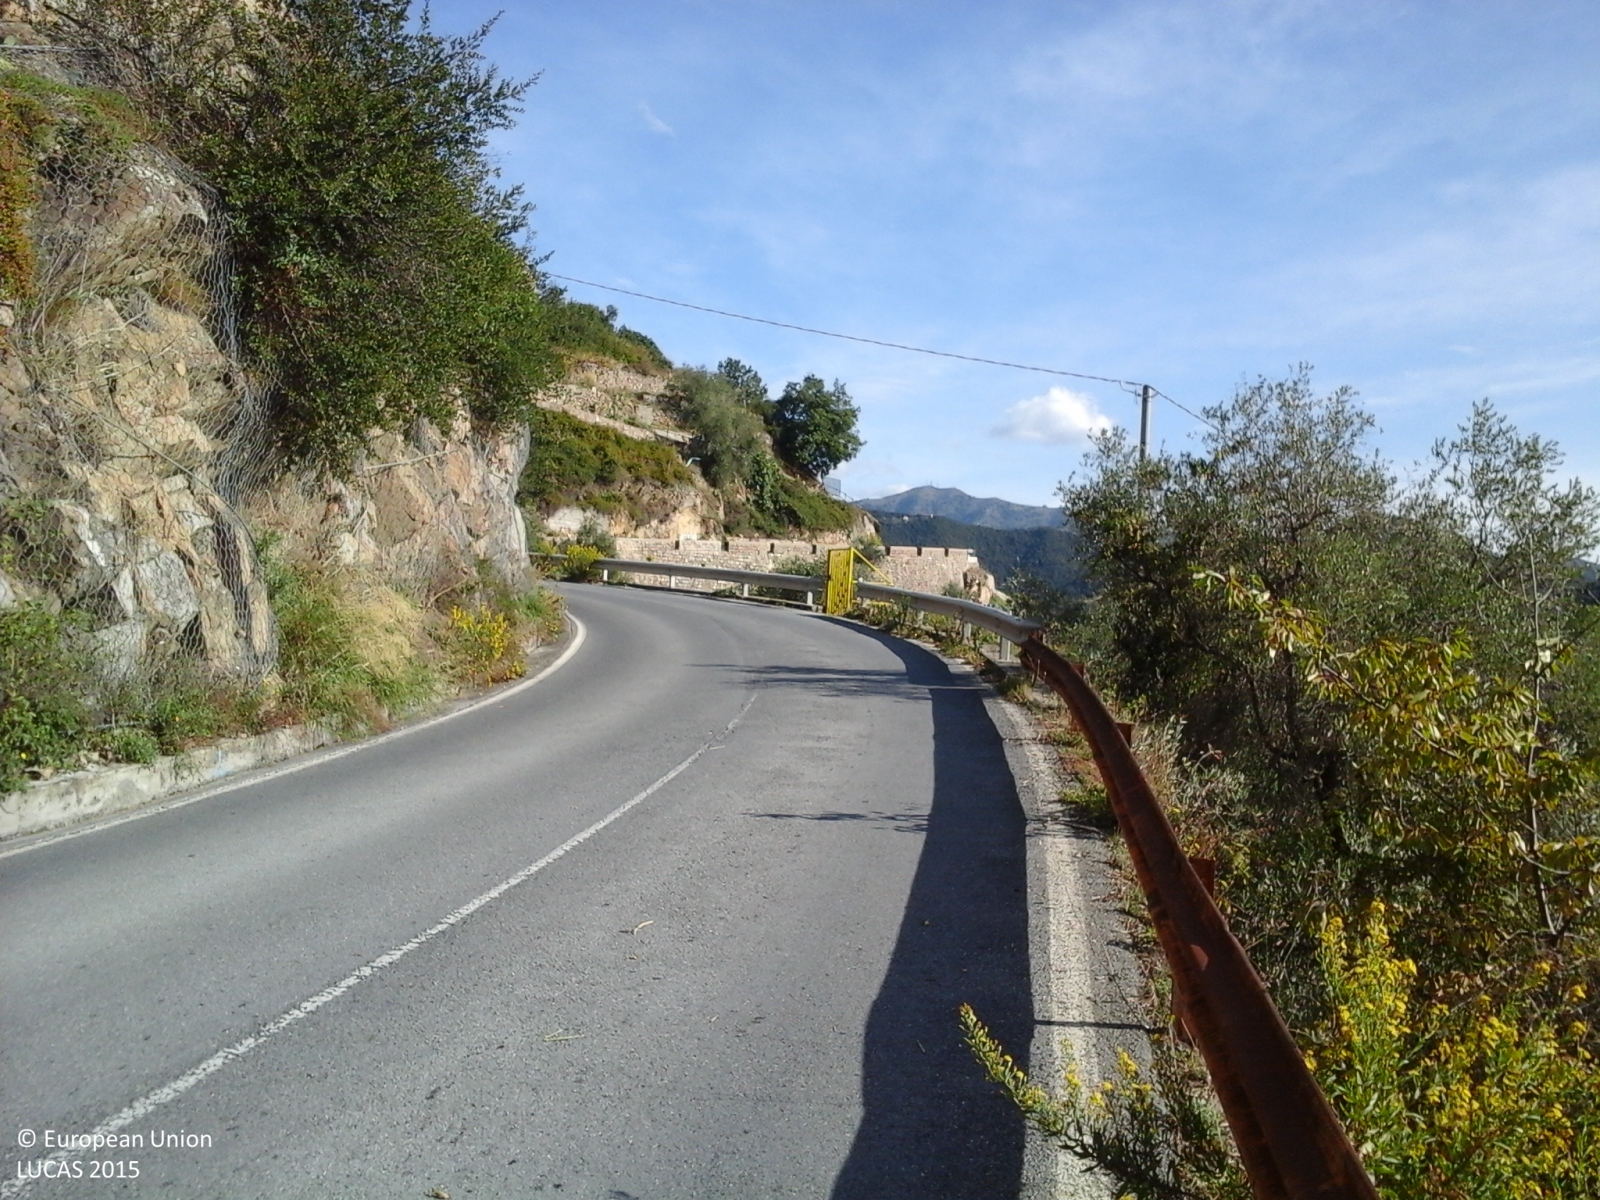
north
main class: Woodland
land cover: Broadleaved woodland
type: thermophilous deciduous forest
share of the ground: > 75 %
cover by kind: broadleaved forest trees 80 %, shrubs 10 %, herbaceous plants 10 %
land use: Semi-natural and natural areas not in use
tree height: > 5 m
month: October
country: IT
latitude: 43.8581
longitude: 7.8033
